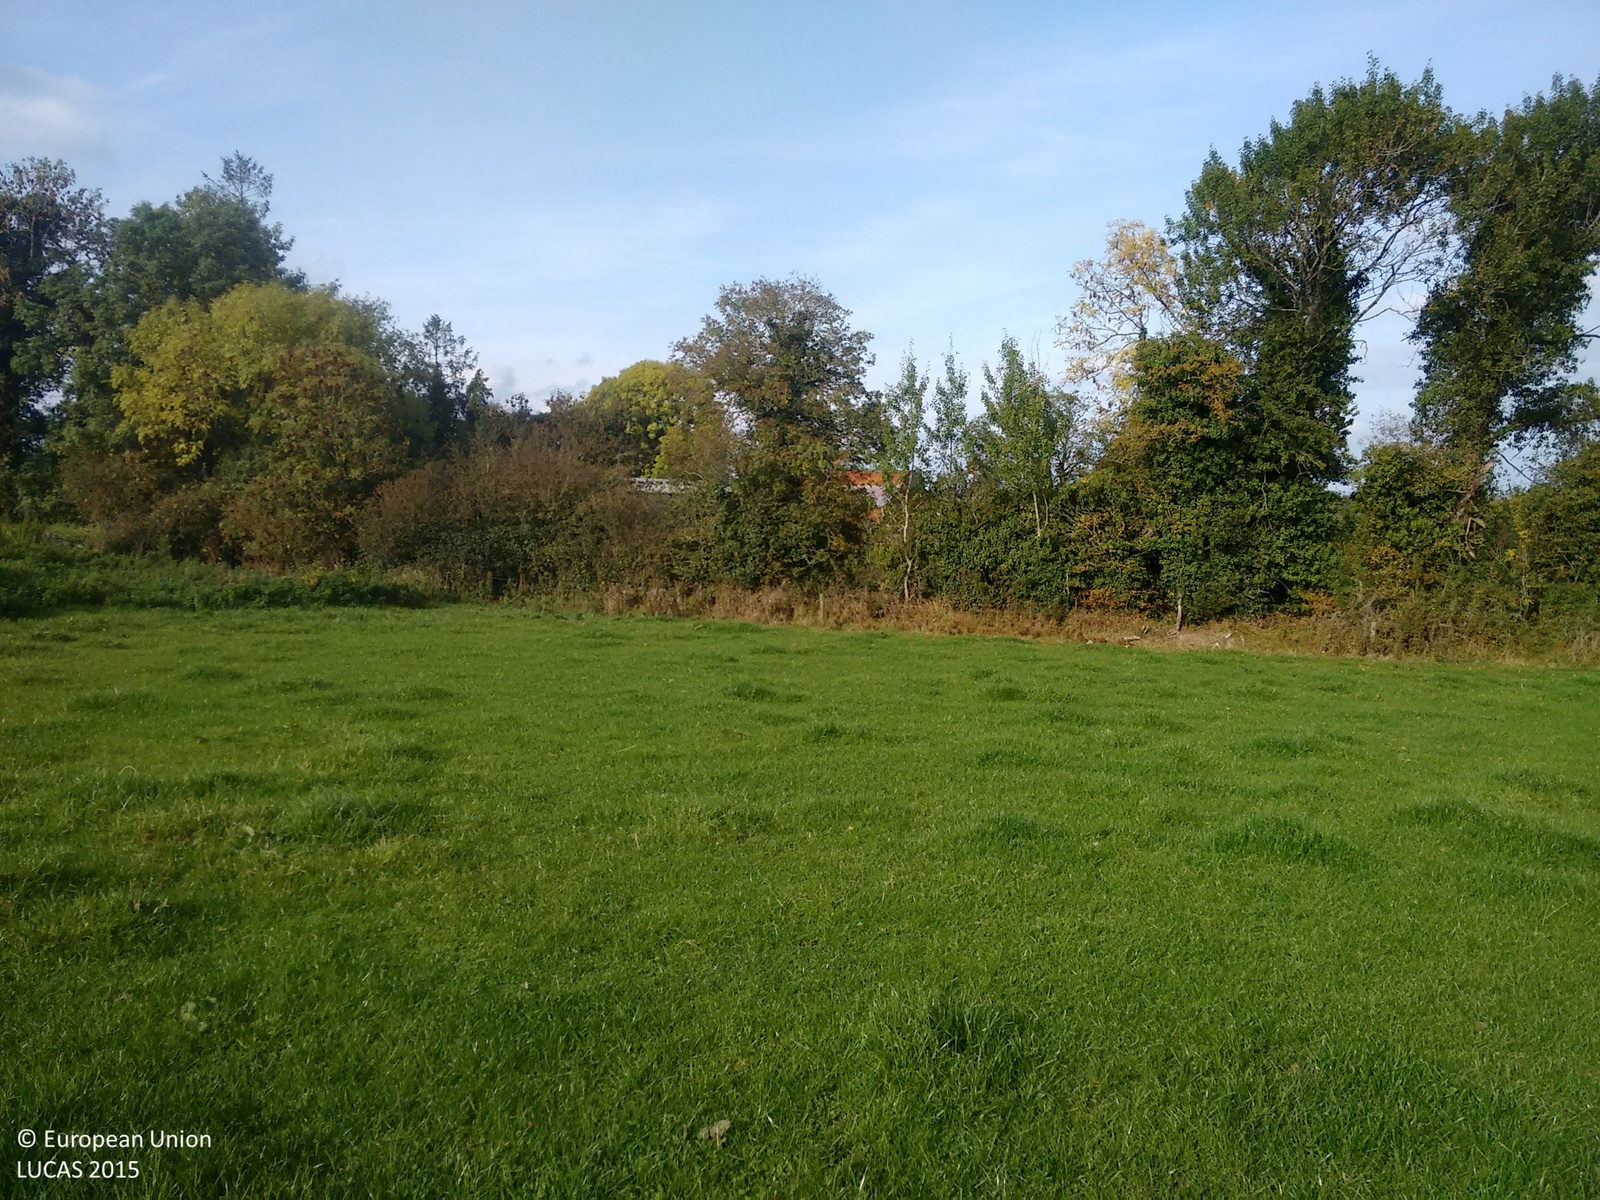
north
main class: Grassland
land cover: Grassland without tree/shrub cover
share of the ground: > 75 %
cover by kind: herbaceous plants 100 %
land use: Agriculture (excluding fallow land and kitchen gardens)
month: October
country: IE
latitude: 52.8690
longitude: -7.6180
